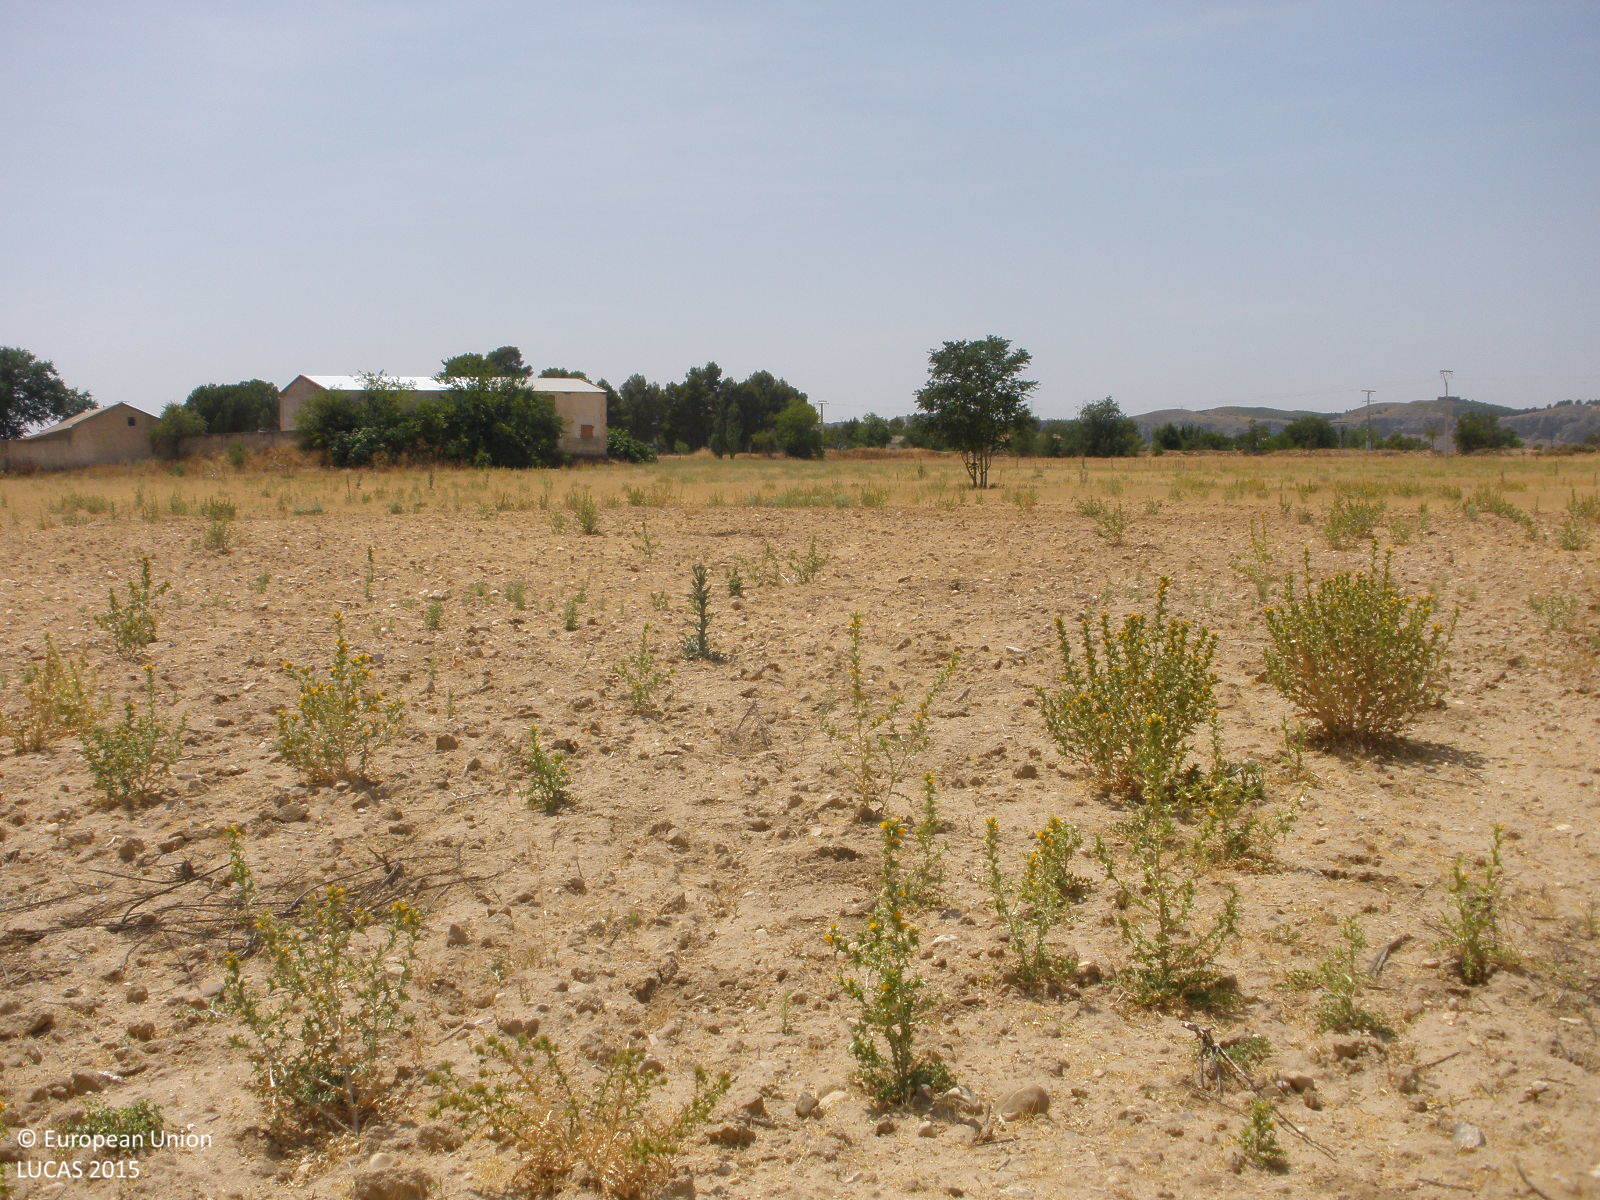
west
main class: Grassland
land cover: Spontaneously vegetated surfaces
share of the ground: 25 - 50 %
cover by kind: unconsolidated bare surface 70 %, herbaceous plants 30 %
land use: Semi-natural and natural areas not in use
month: July
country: ES
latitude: 40.2996
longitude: -3.5042
